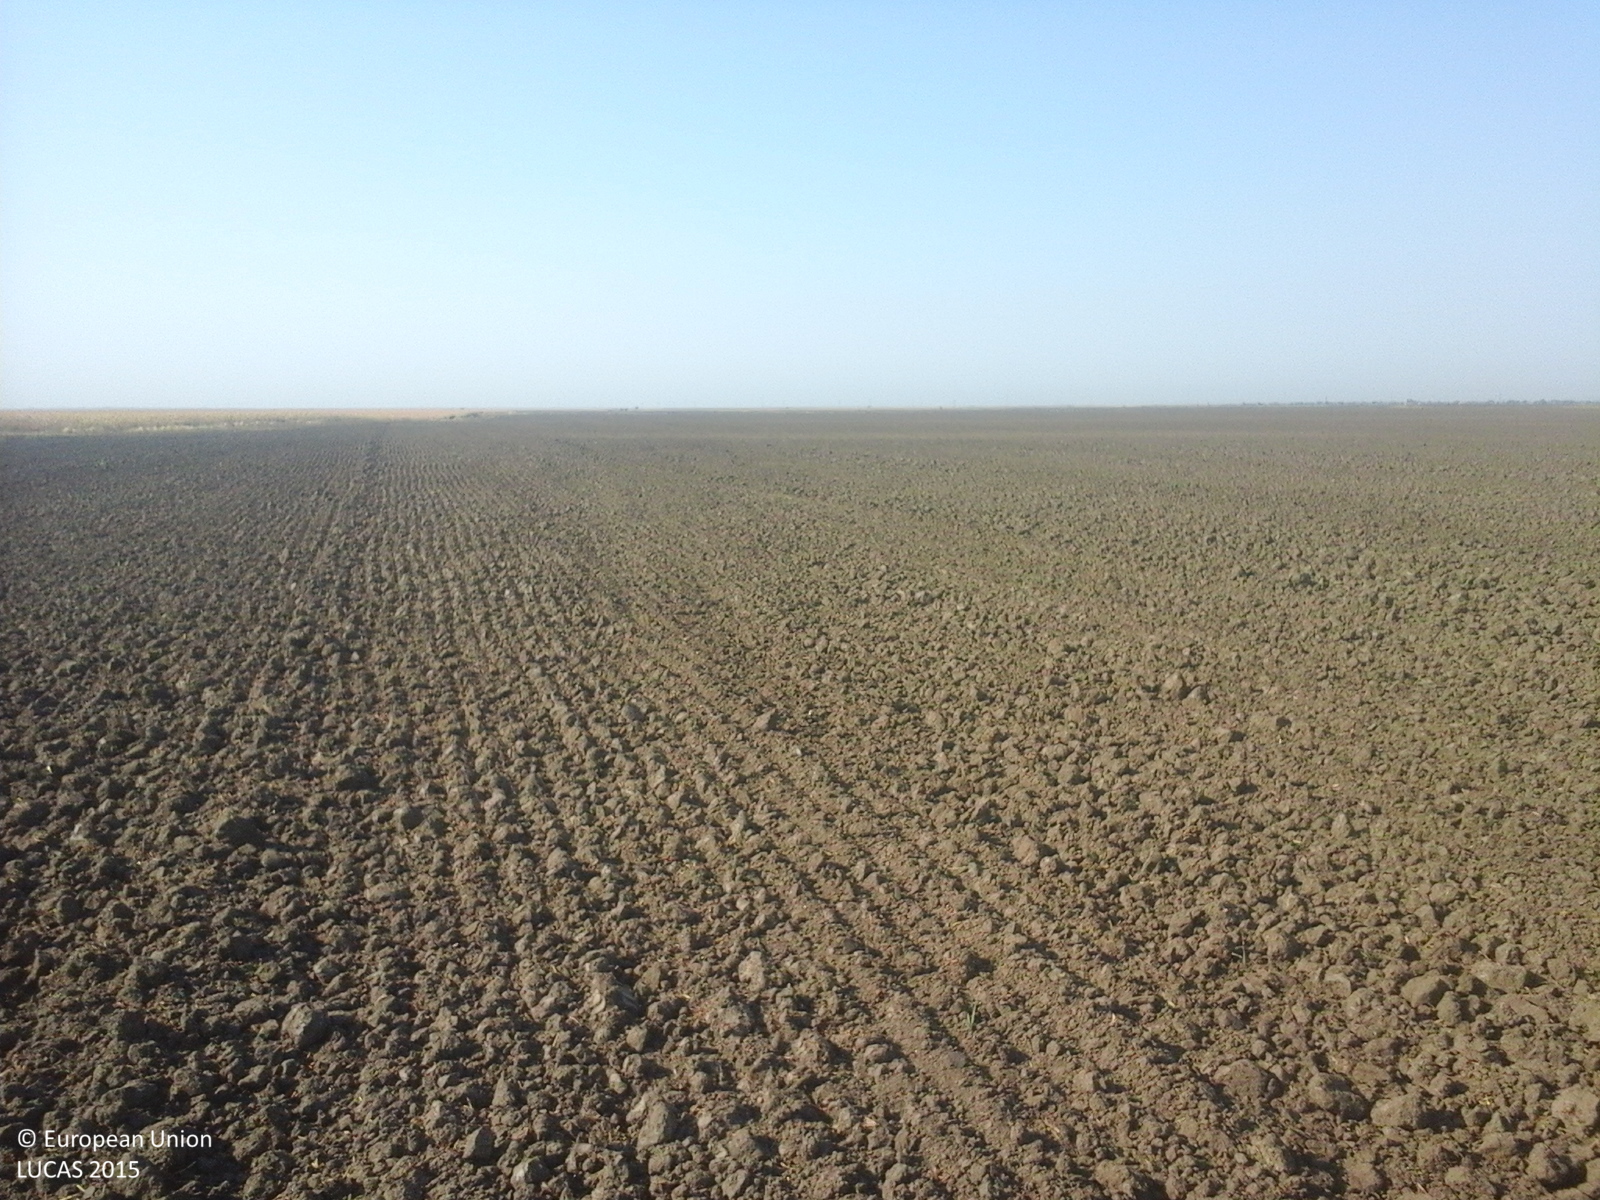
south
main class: Cropland
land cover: Barley
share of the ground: < 10 %
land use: Agriculture (excluding fallow land and kitchen gardens)
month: August
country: RO
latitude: 44.2016
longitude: 23.0197
